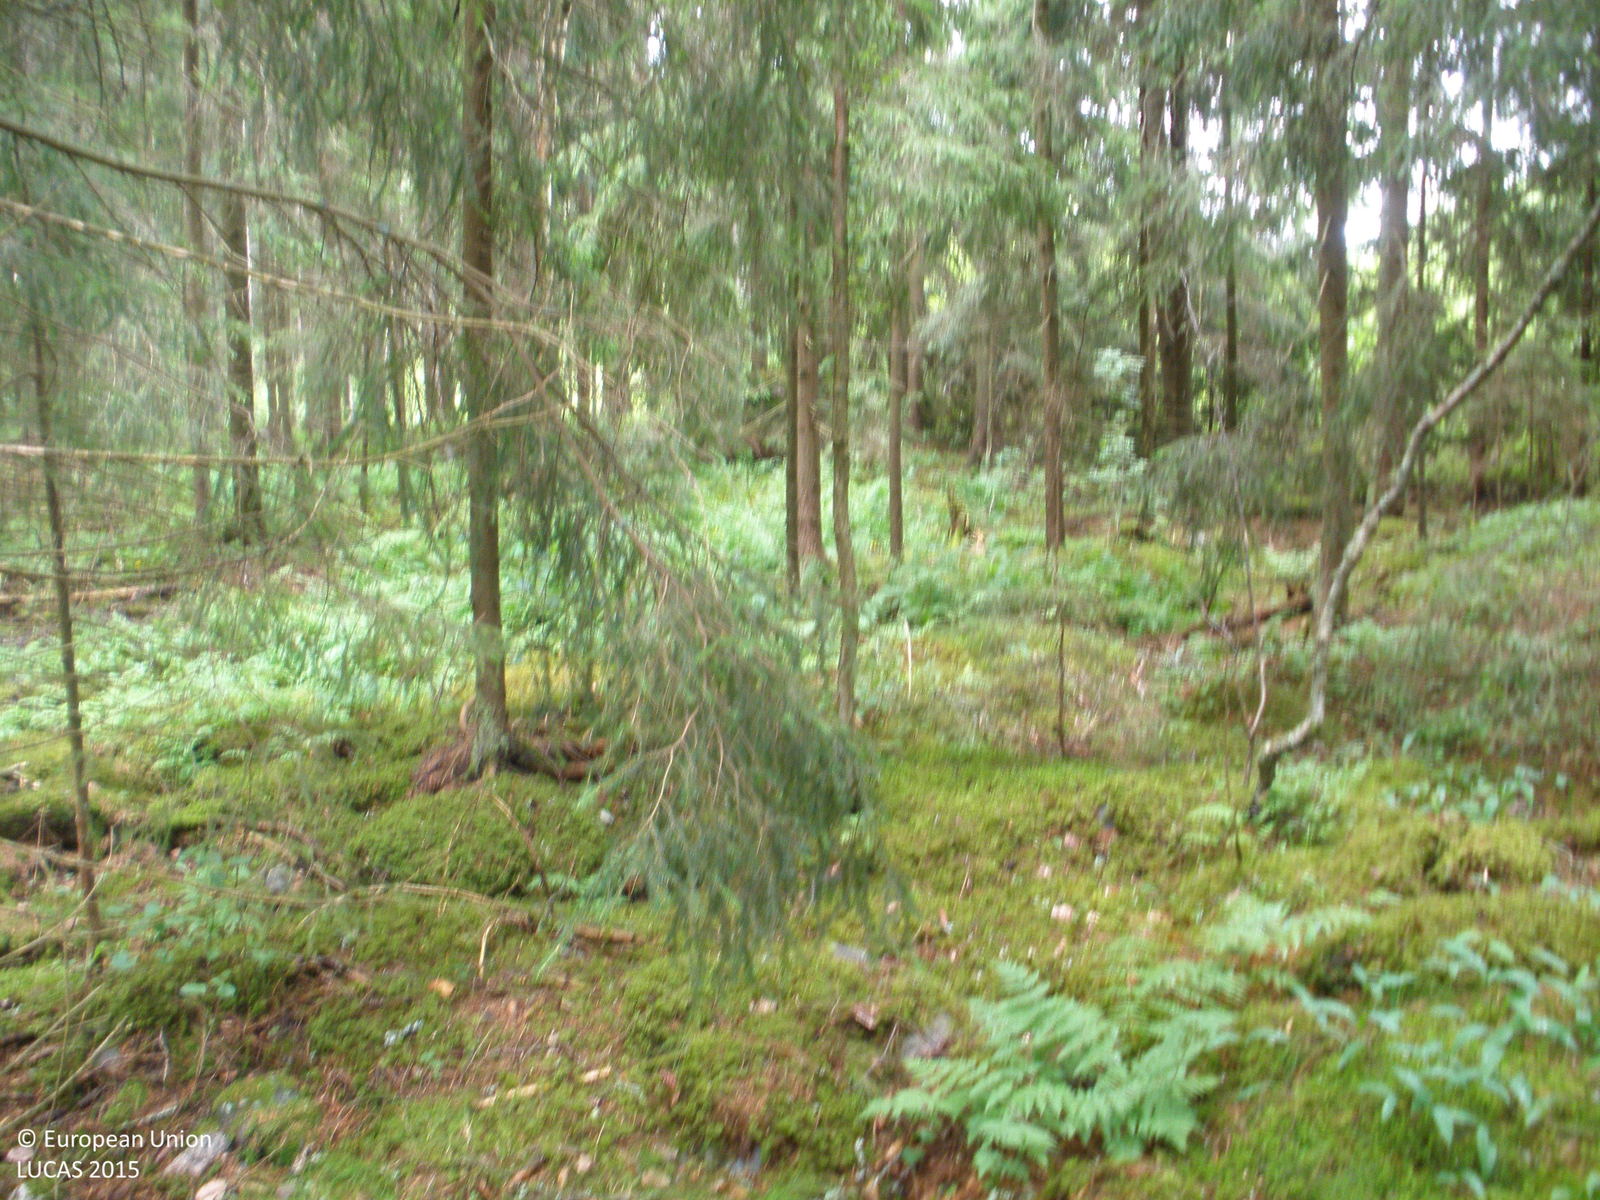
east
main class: Woodland
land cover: Spruce dominated coniferous woodland
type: boreal forest
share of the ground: > 75 %
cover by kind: coniferous forest trees 80 %, herbaceous plants 10 %, broadleaved forest trees 5 %, lichens and mosses 5 %
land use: Forestry
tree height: > 5 m
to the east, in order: Spruce dominated coniferous woodland; Spruce dominated mixed woodland; Spruce dominated coniferous woodland; Spruce dominated mixed woodland; Broadleaved woodland
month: July
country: FI
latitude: 61.3392
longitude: 23.7097
